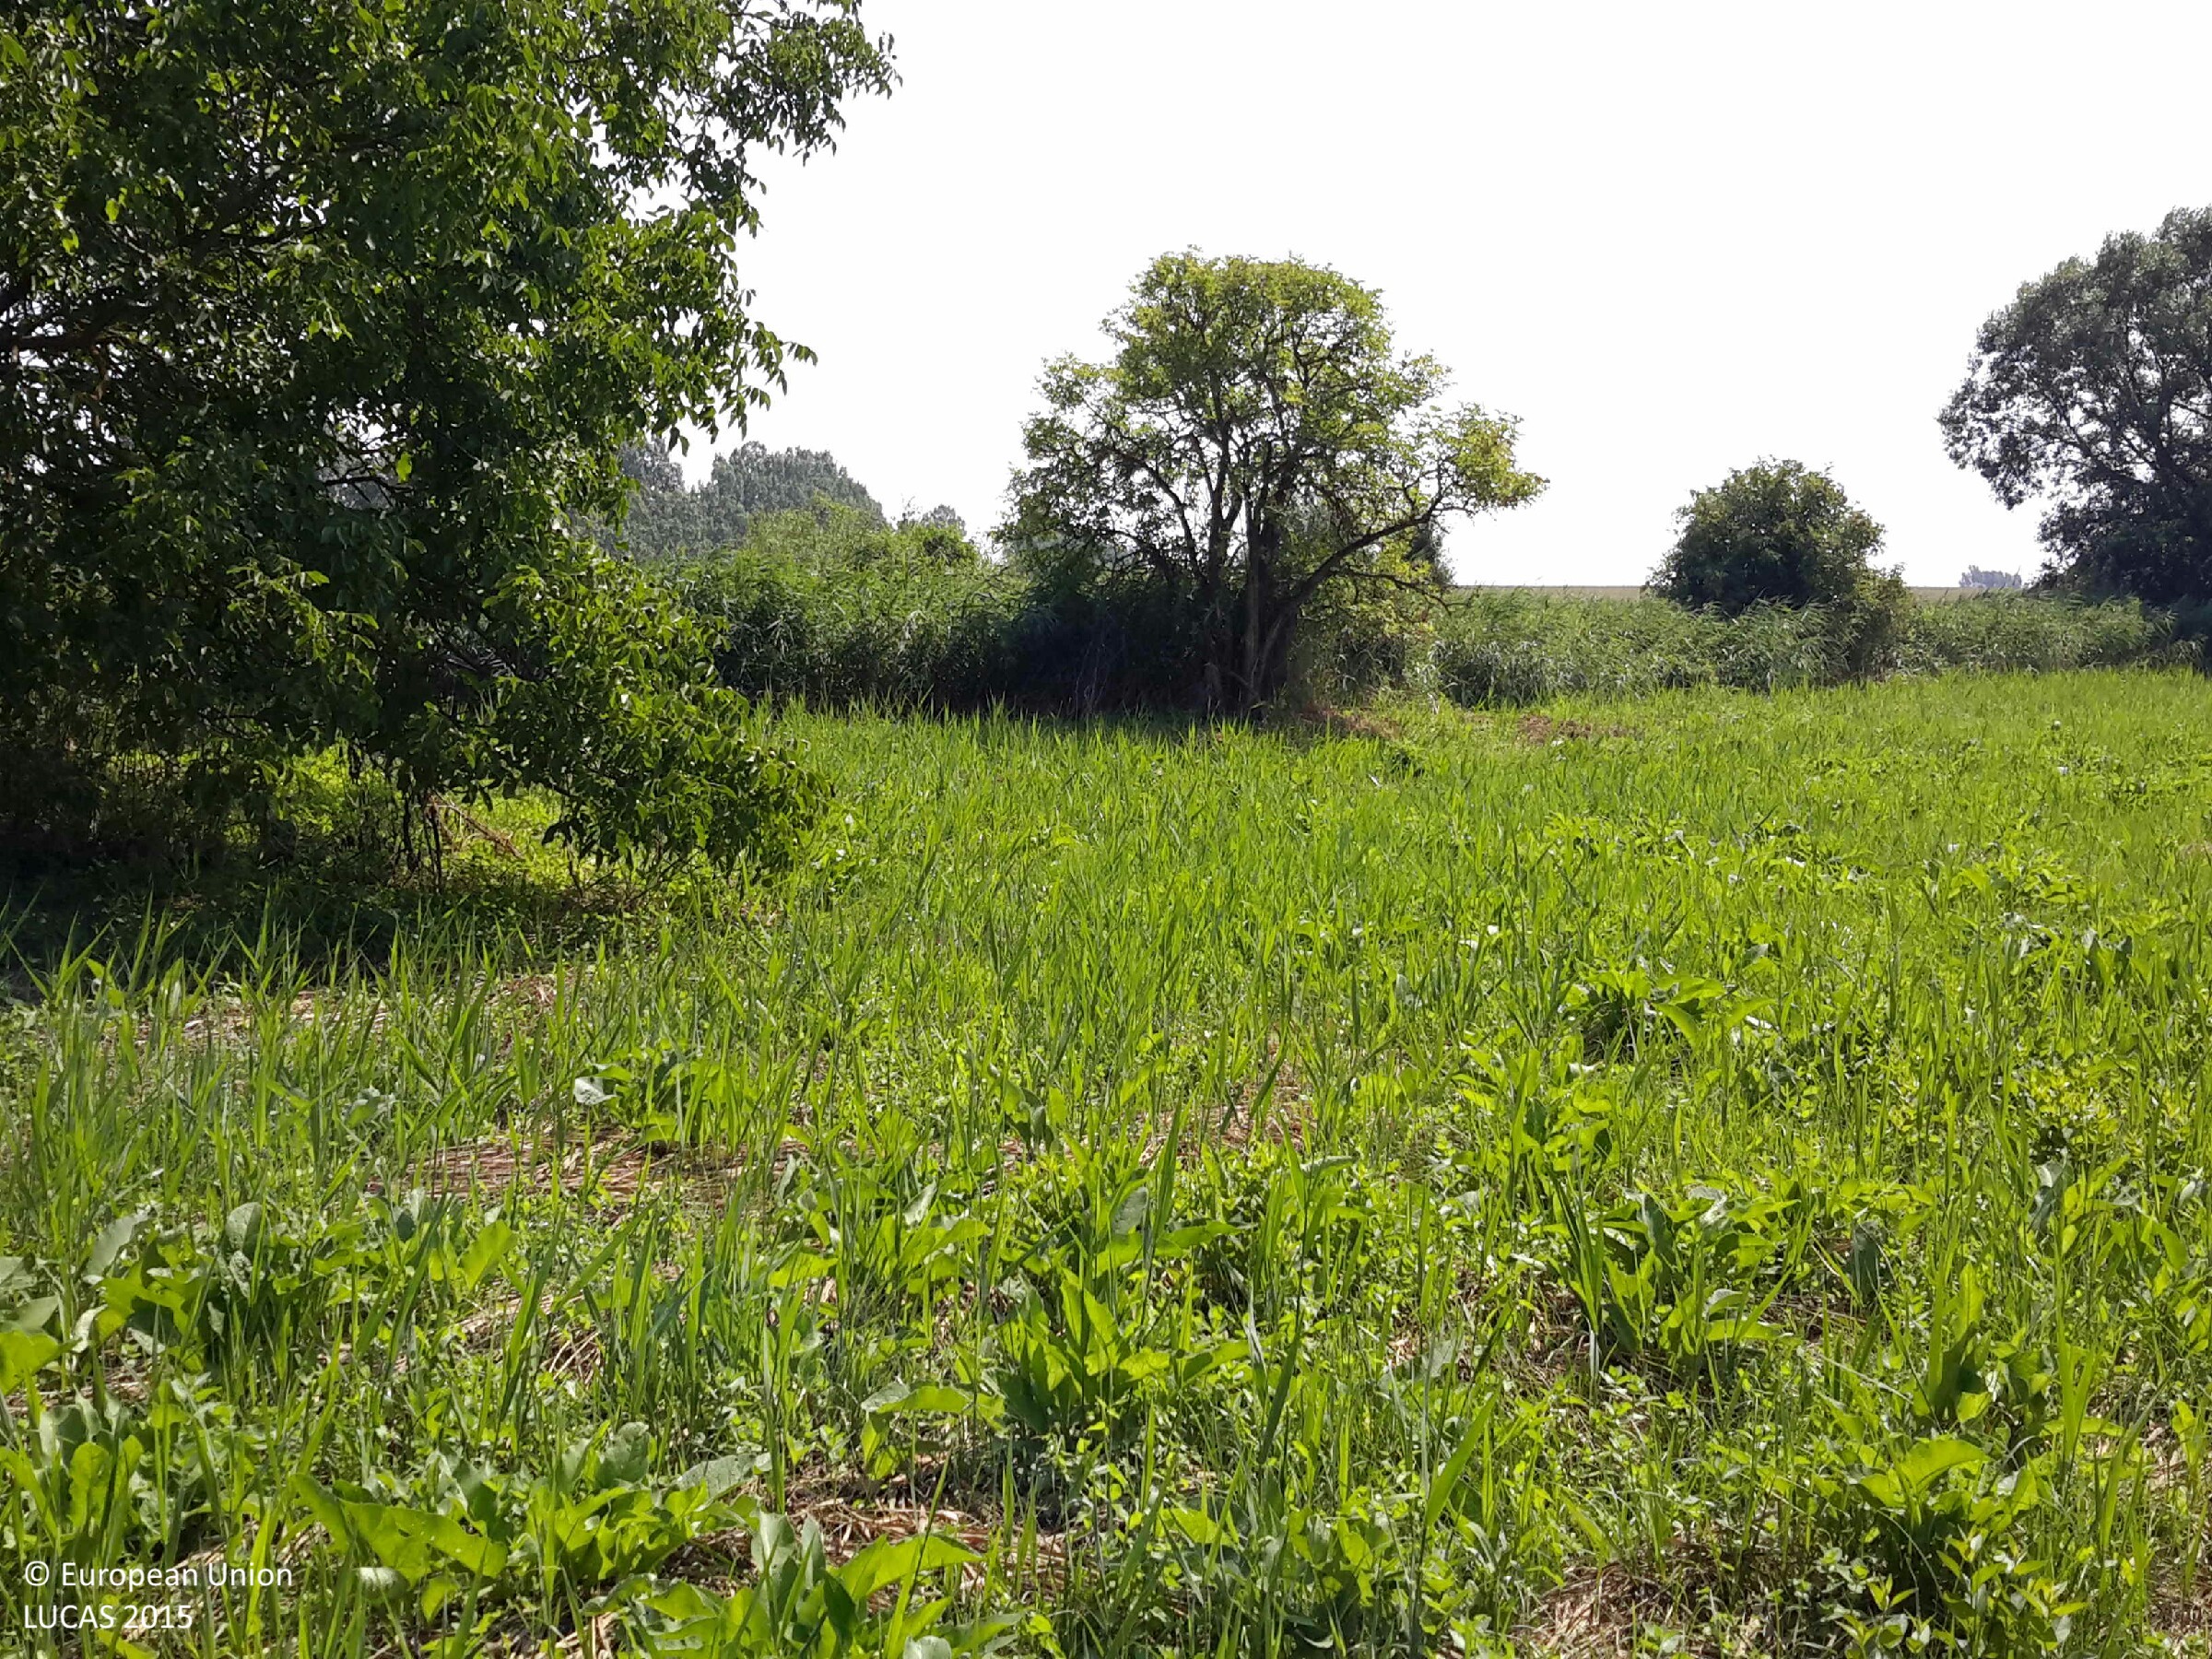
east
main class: Grassland
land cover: Spontaneously vegetated surfaces
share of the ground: > 75 %
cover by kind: herbaceous plants 100 %
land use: Agriculture (excluding fallow land and kitchen gardens)
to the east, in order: Spontaneously vegetated surfaces; Single bushes/trees; Ditches and canals; Spontaneously vegetated surfaces; Maize
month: July
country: HU
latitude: 47.4075
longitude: 16.6700
